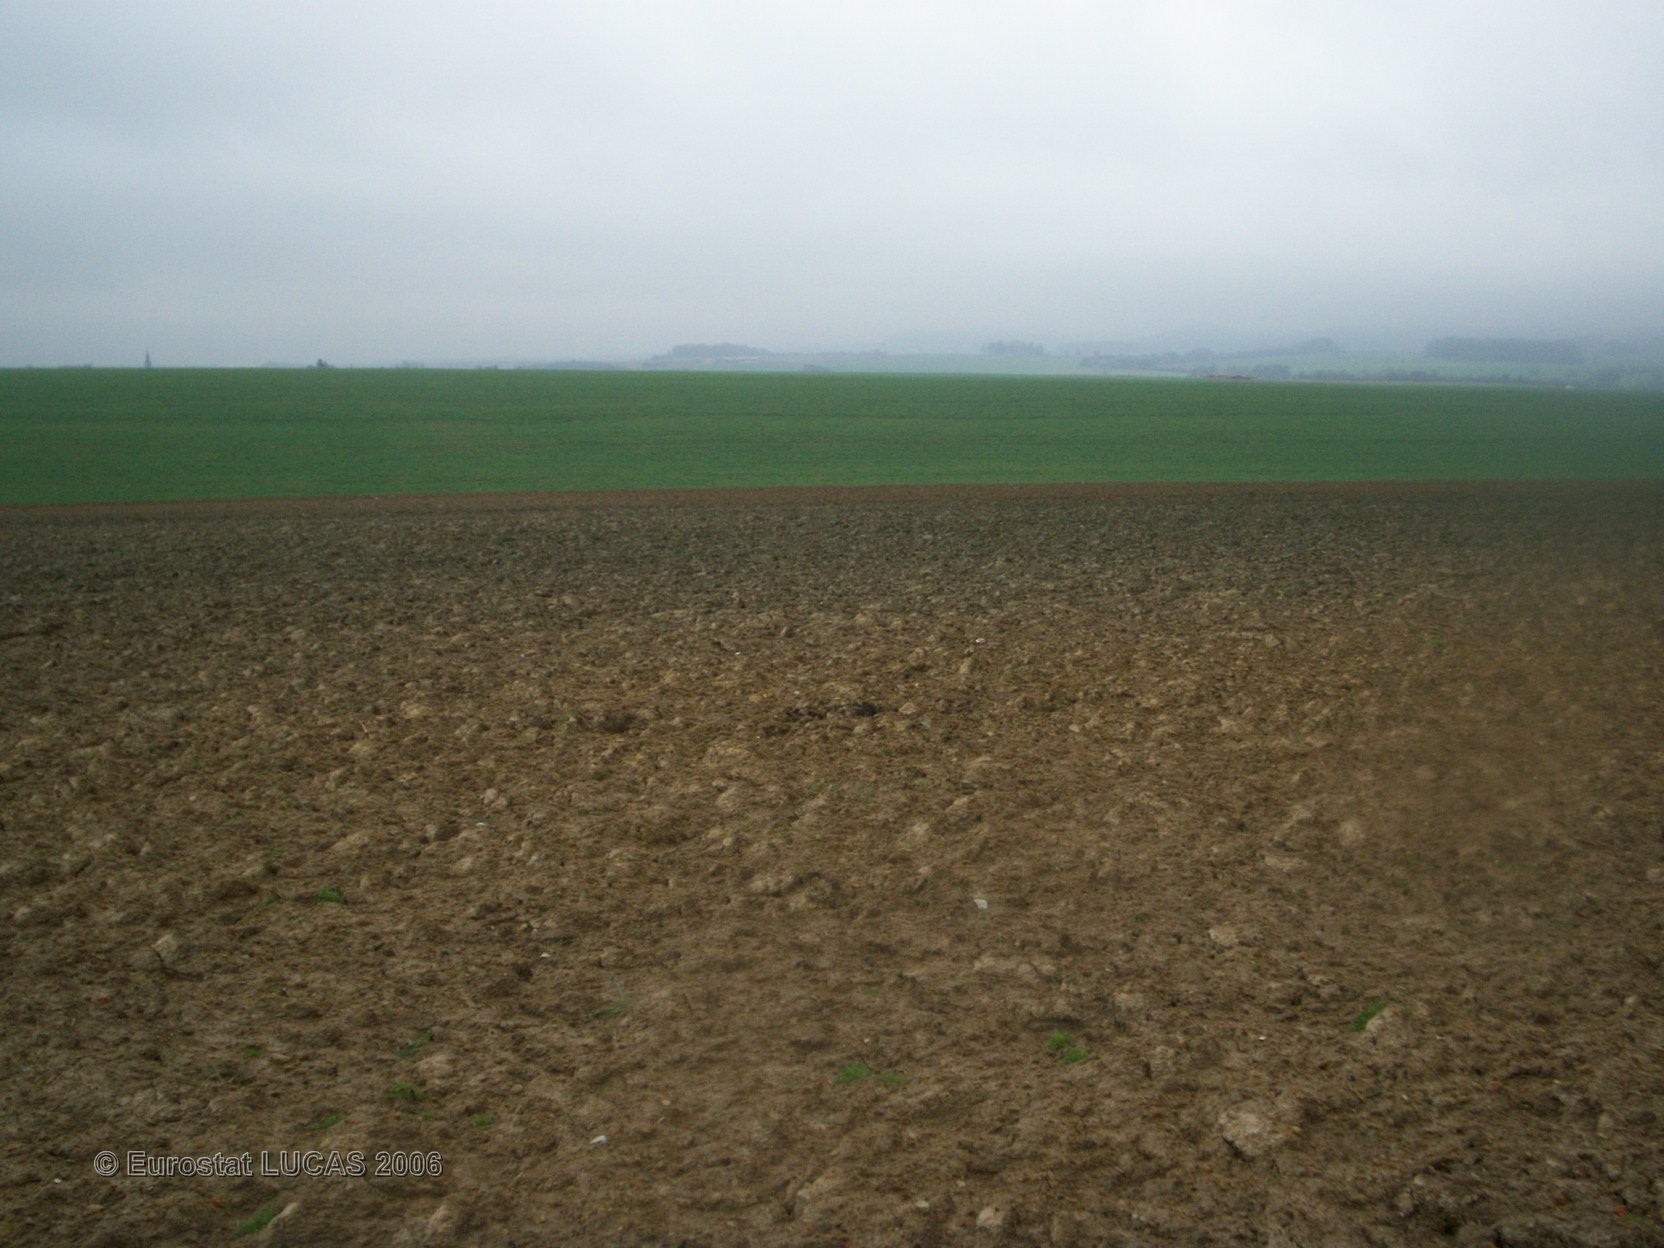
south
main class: Cropland
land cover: Maize
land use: Agriculture (excluding fallow land and kitchen gardens)
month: June
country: FR
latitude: 49.1589
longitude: 5.0751
